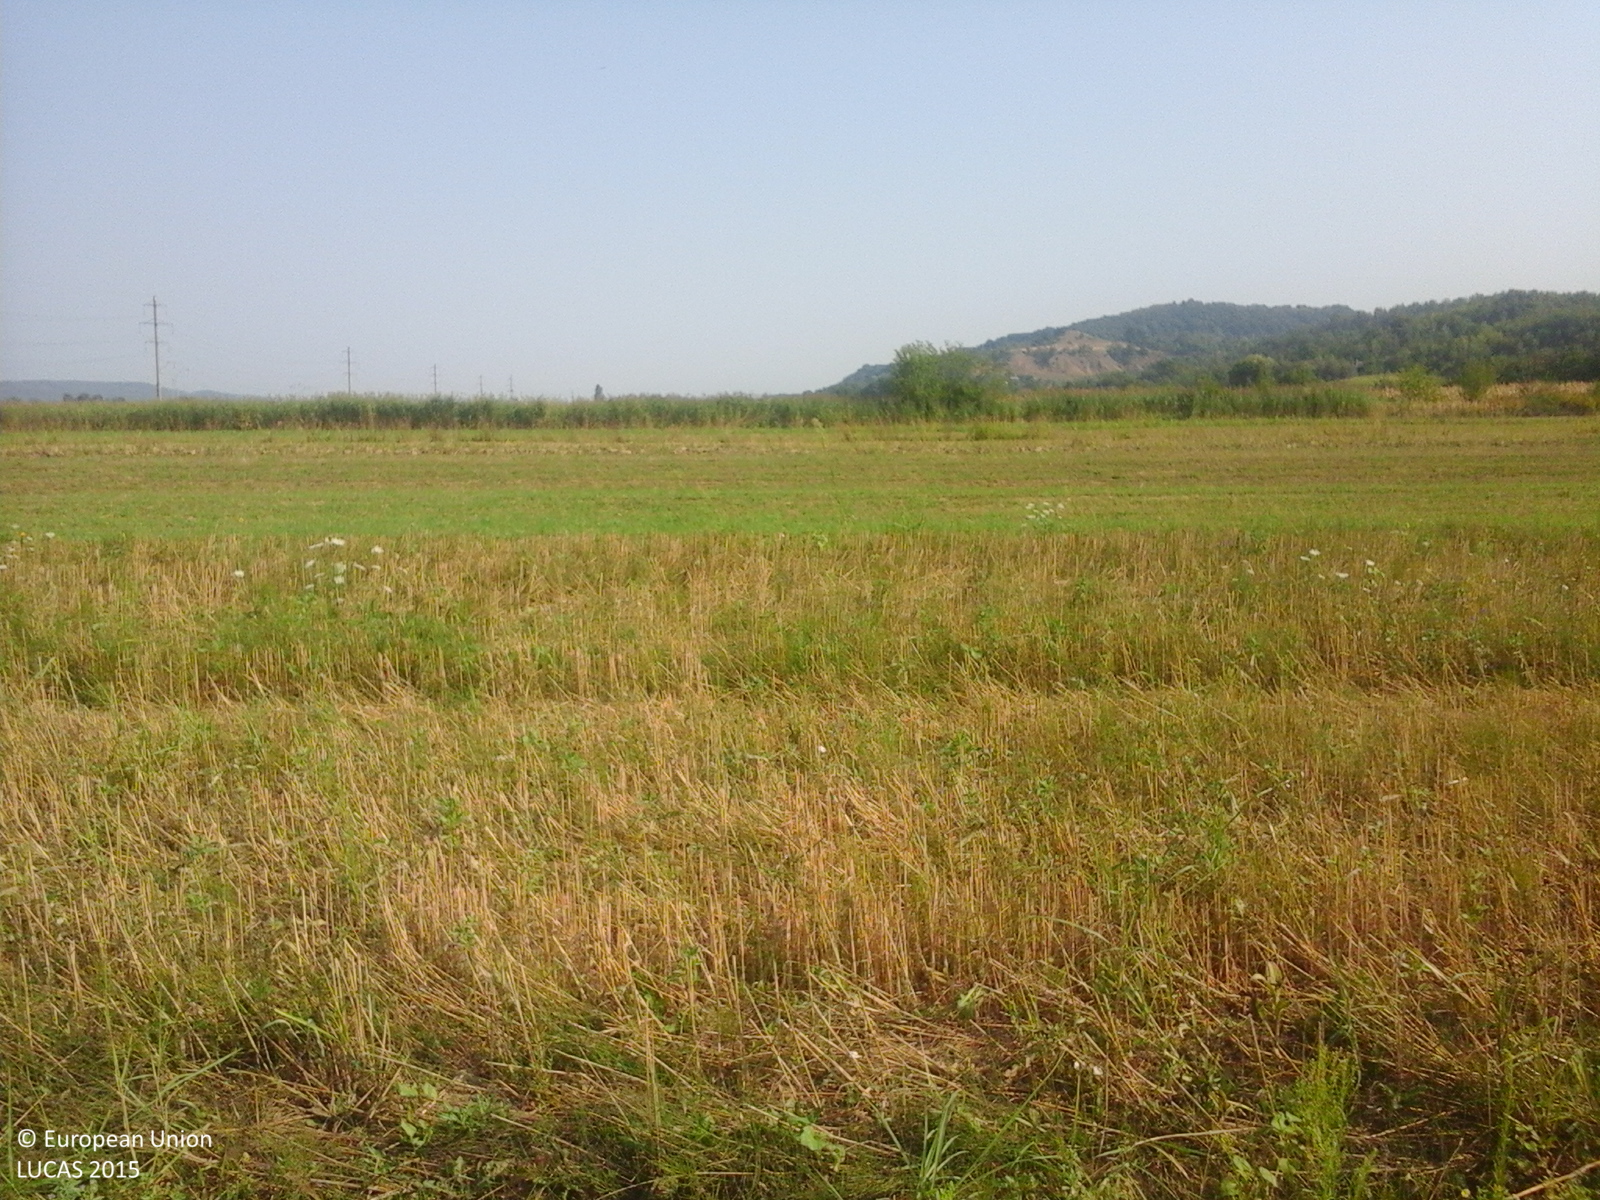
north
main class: Cropland
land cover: Lucerne
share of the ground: > 75 %
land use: Agriculture (excluding fallow land and kitchen gardens)
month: August
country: RO
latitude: 44.8476
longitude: 23.5314
